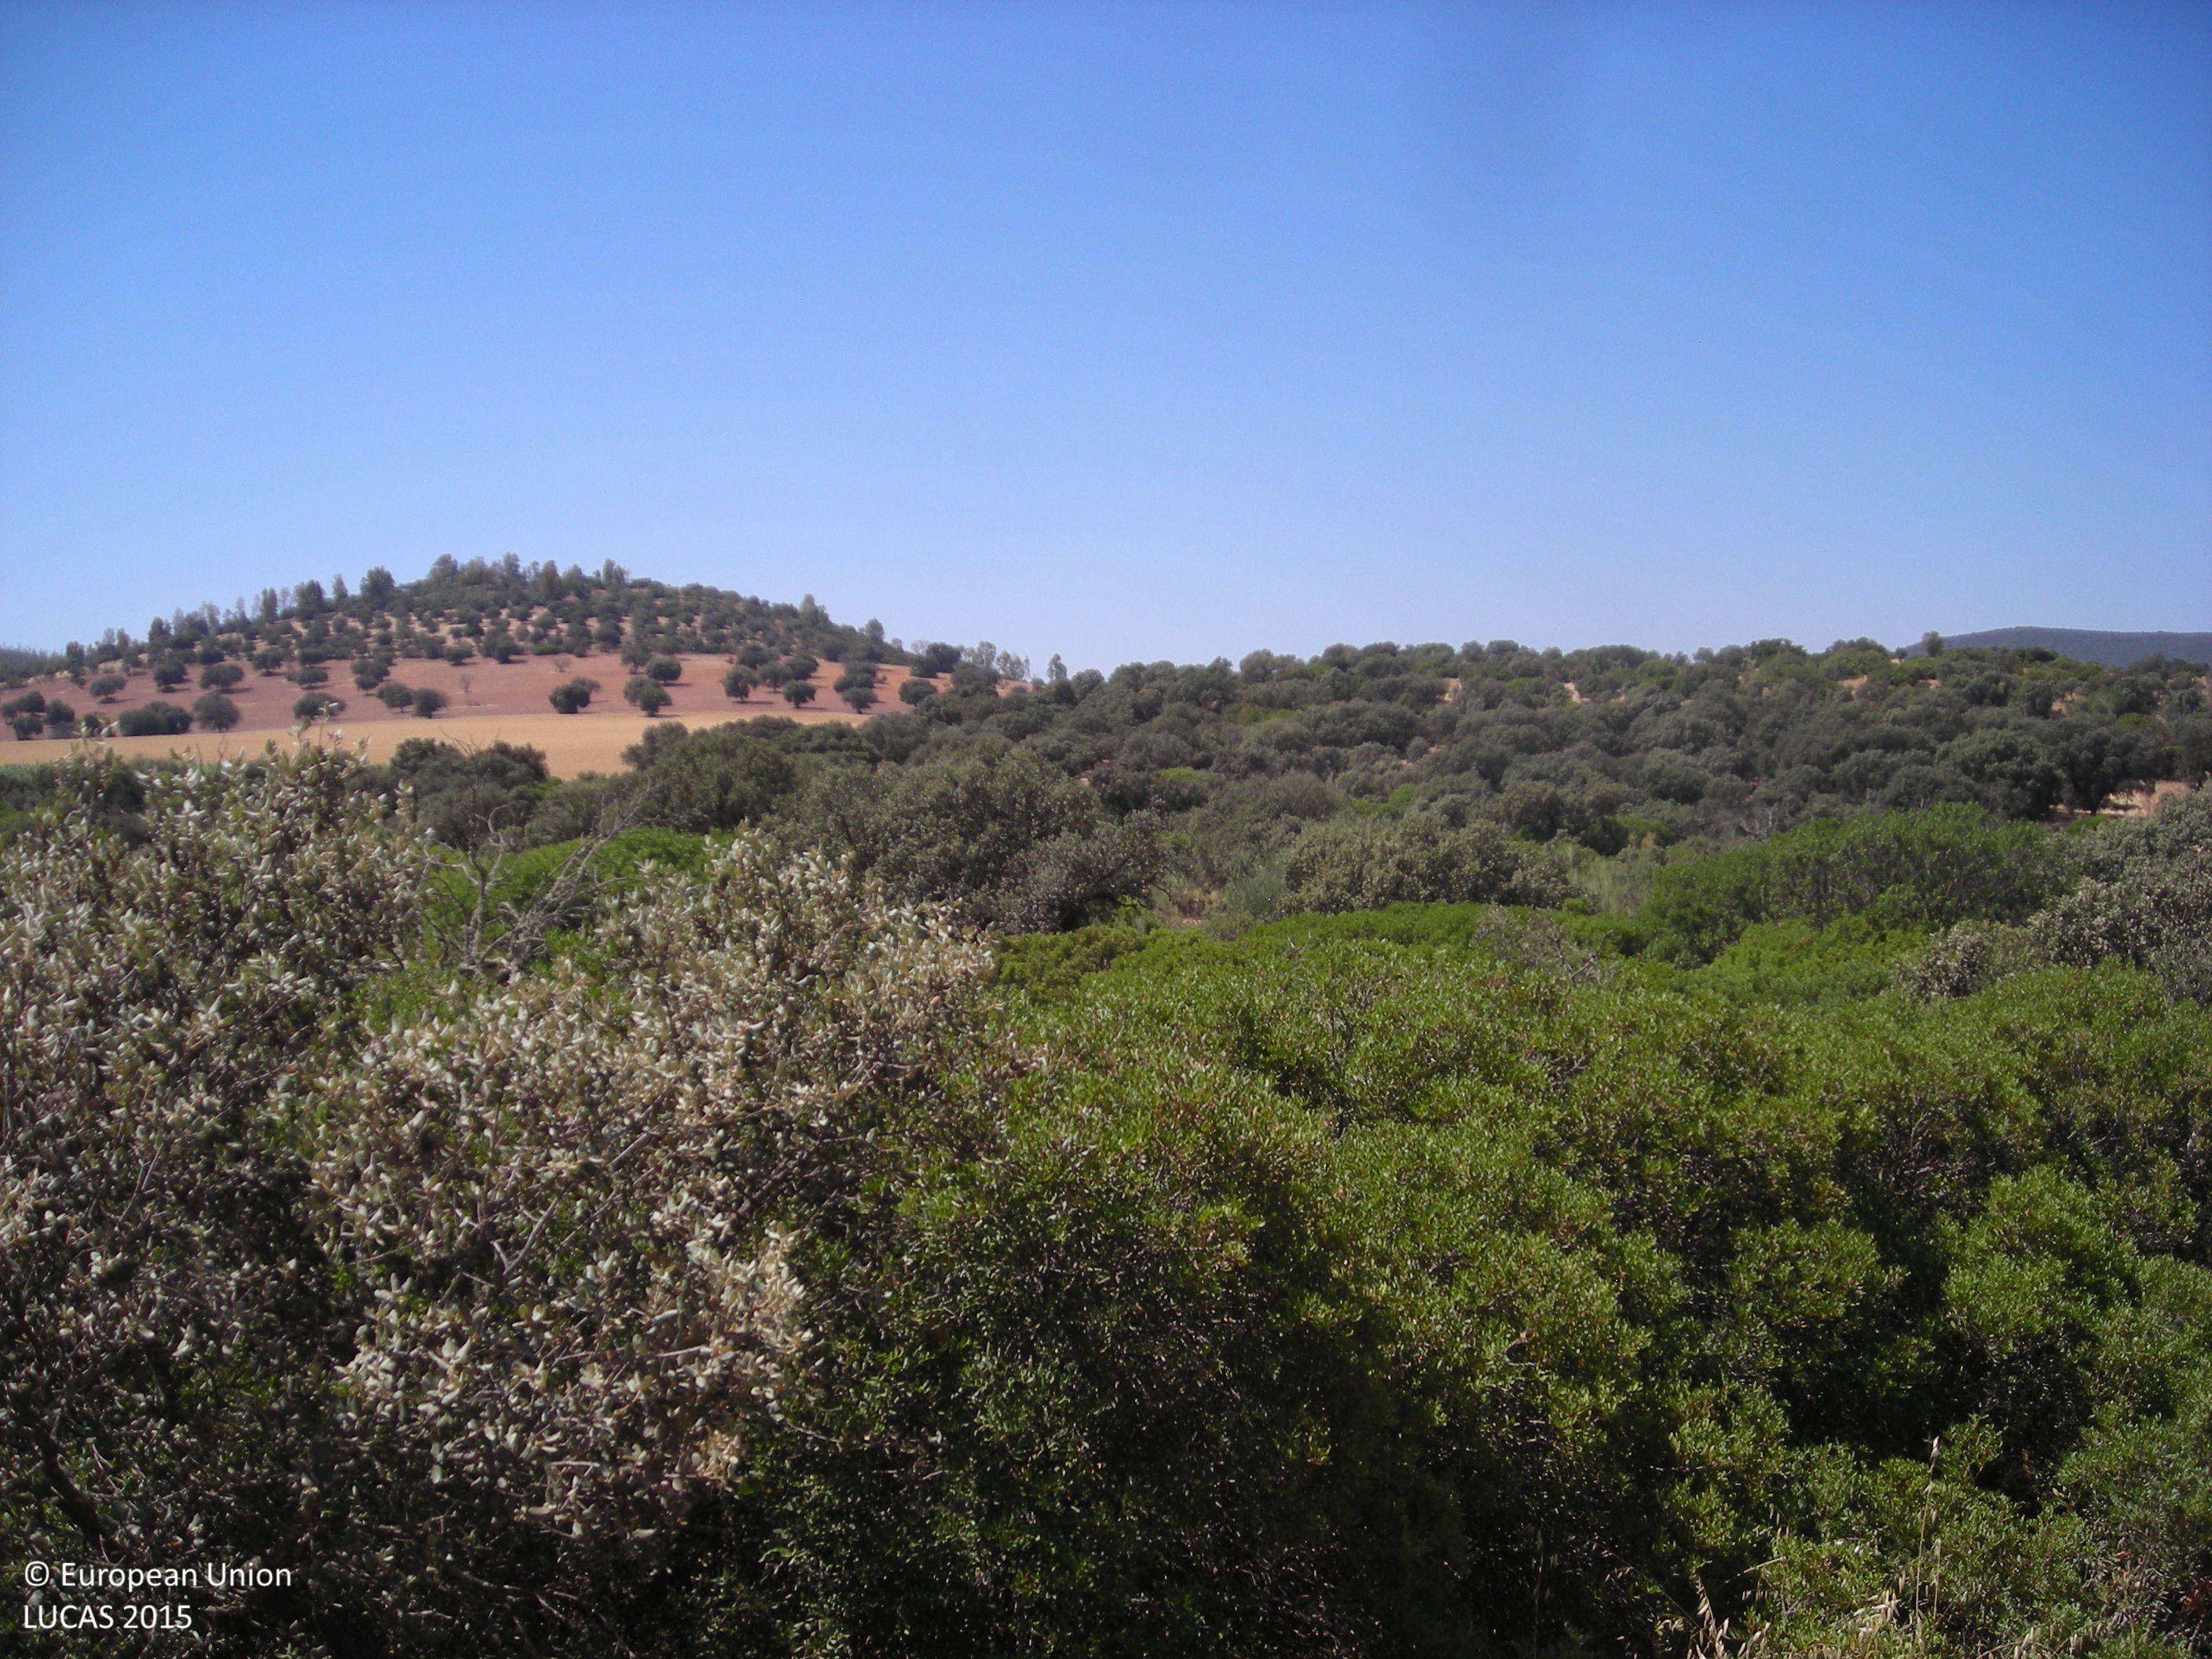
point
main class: Grassland
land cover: Grassland without tree/shrub cover
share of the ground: > 75 %
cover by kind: herbaceous plants 100 %
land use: Agriculture (excluding fallow land and kitchen gardens)
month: July
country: ES
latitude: 38.7740
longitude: -5.9198
